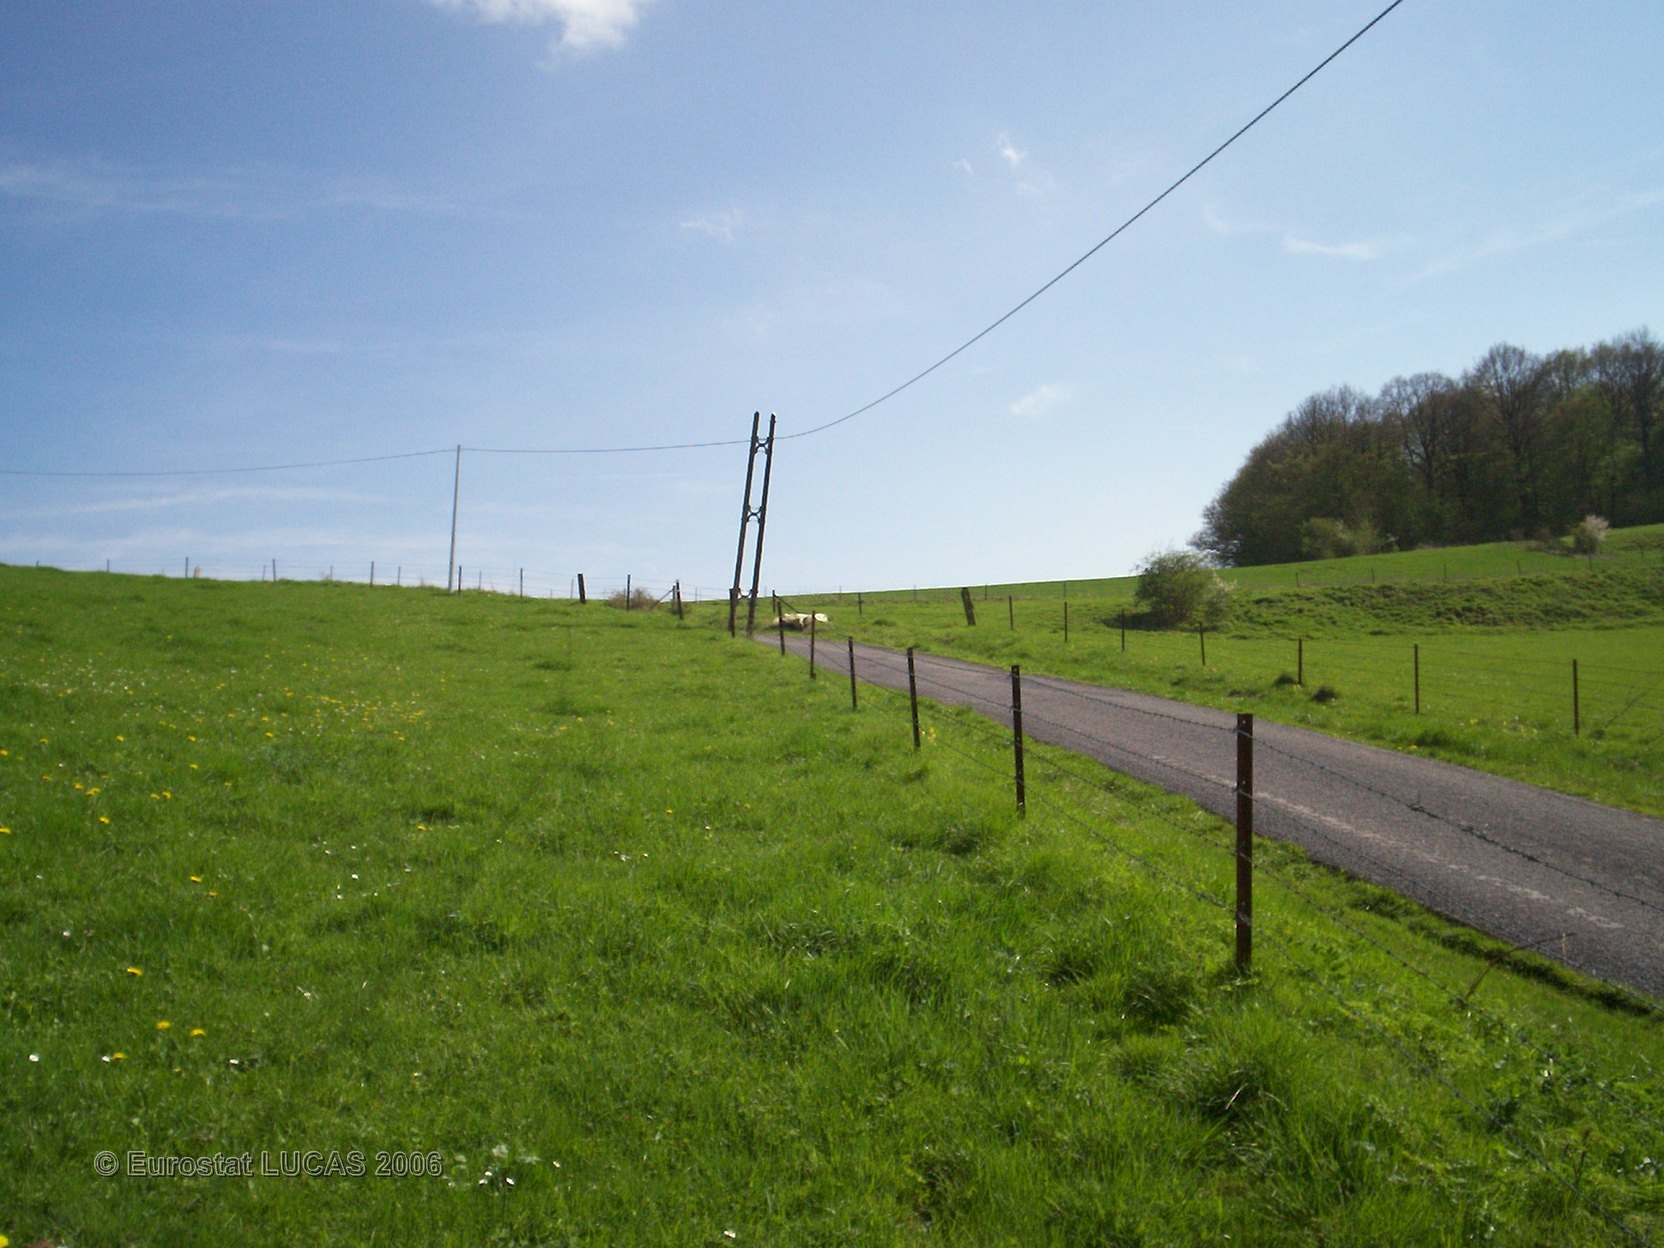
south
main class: Grassland
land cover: Grassland without tree/shrub cover
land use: Agriculture (excluding fallow land and kitchen gardens)
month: May
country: FR
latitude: 49.8079
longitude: 4.3122
